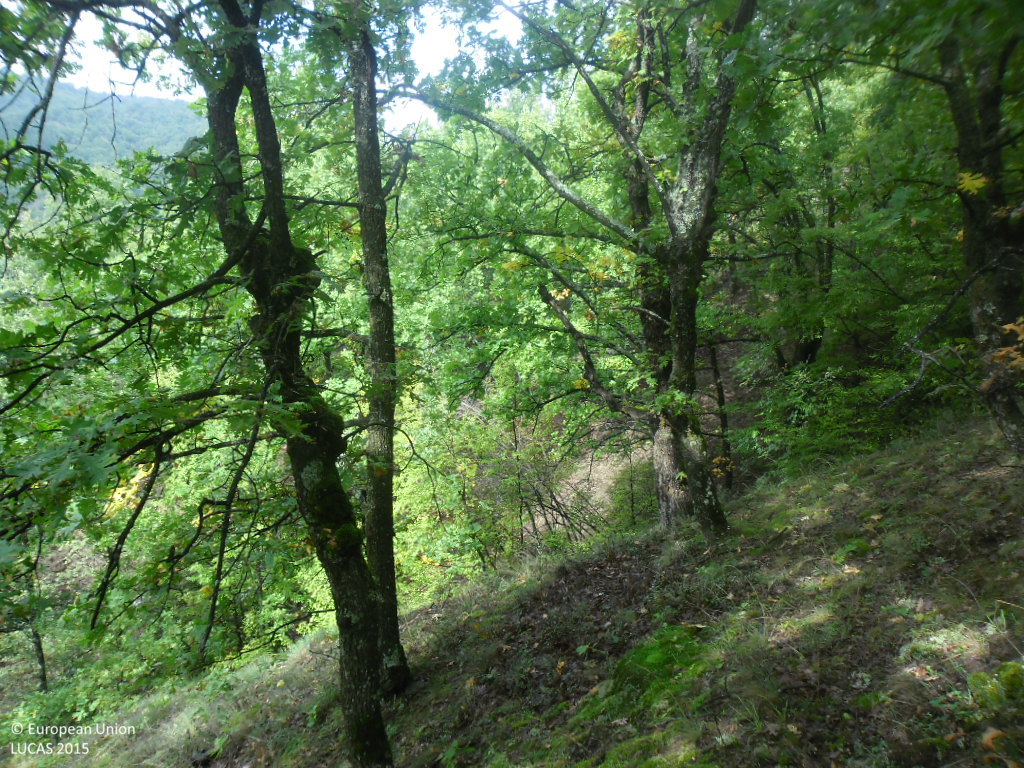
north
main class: Woodland
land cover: Broadleaved woodland
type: mesophytic deciduous forest
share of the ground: > 75 %
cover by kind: broadleaved forest trees 95 %, unconsolidated bare surface 5 %
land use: Forestry
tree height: > 5 m
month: October
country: BG
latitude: 41.9345
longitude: 23.1825
